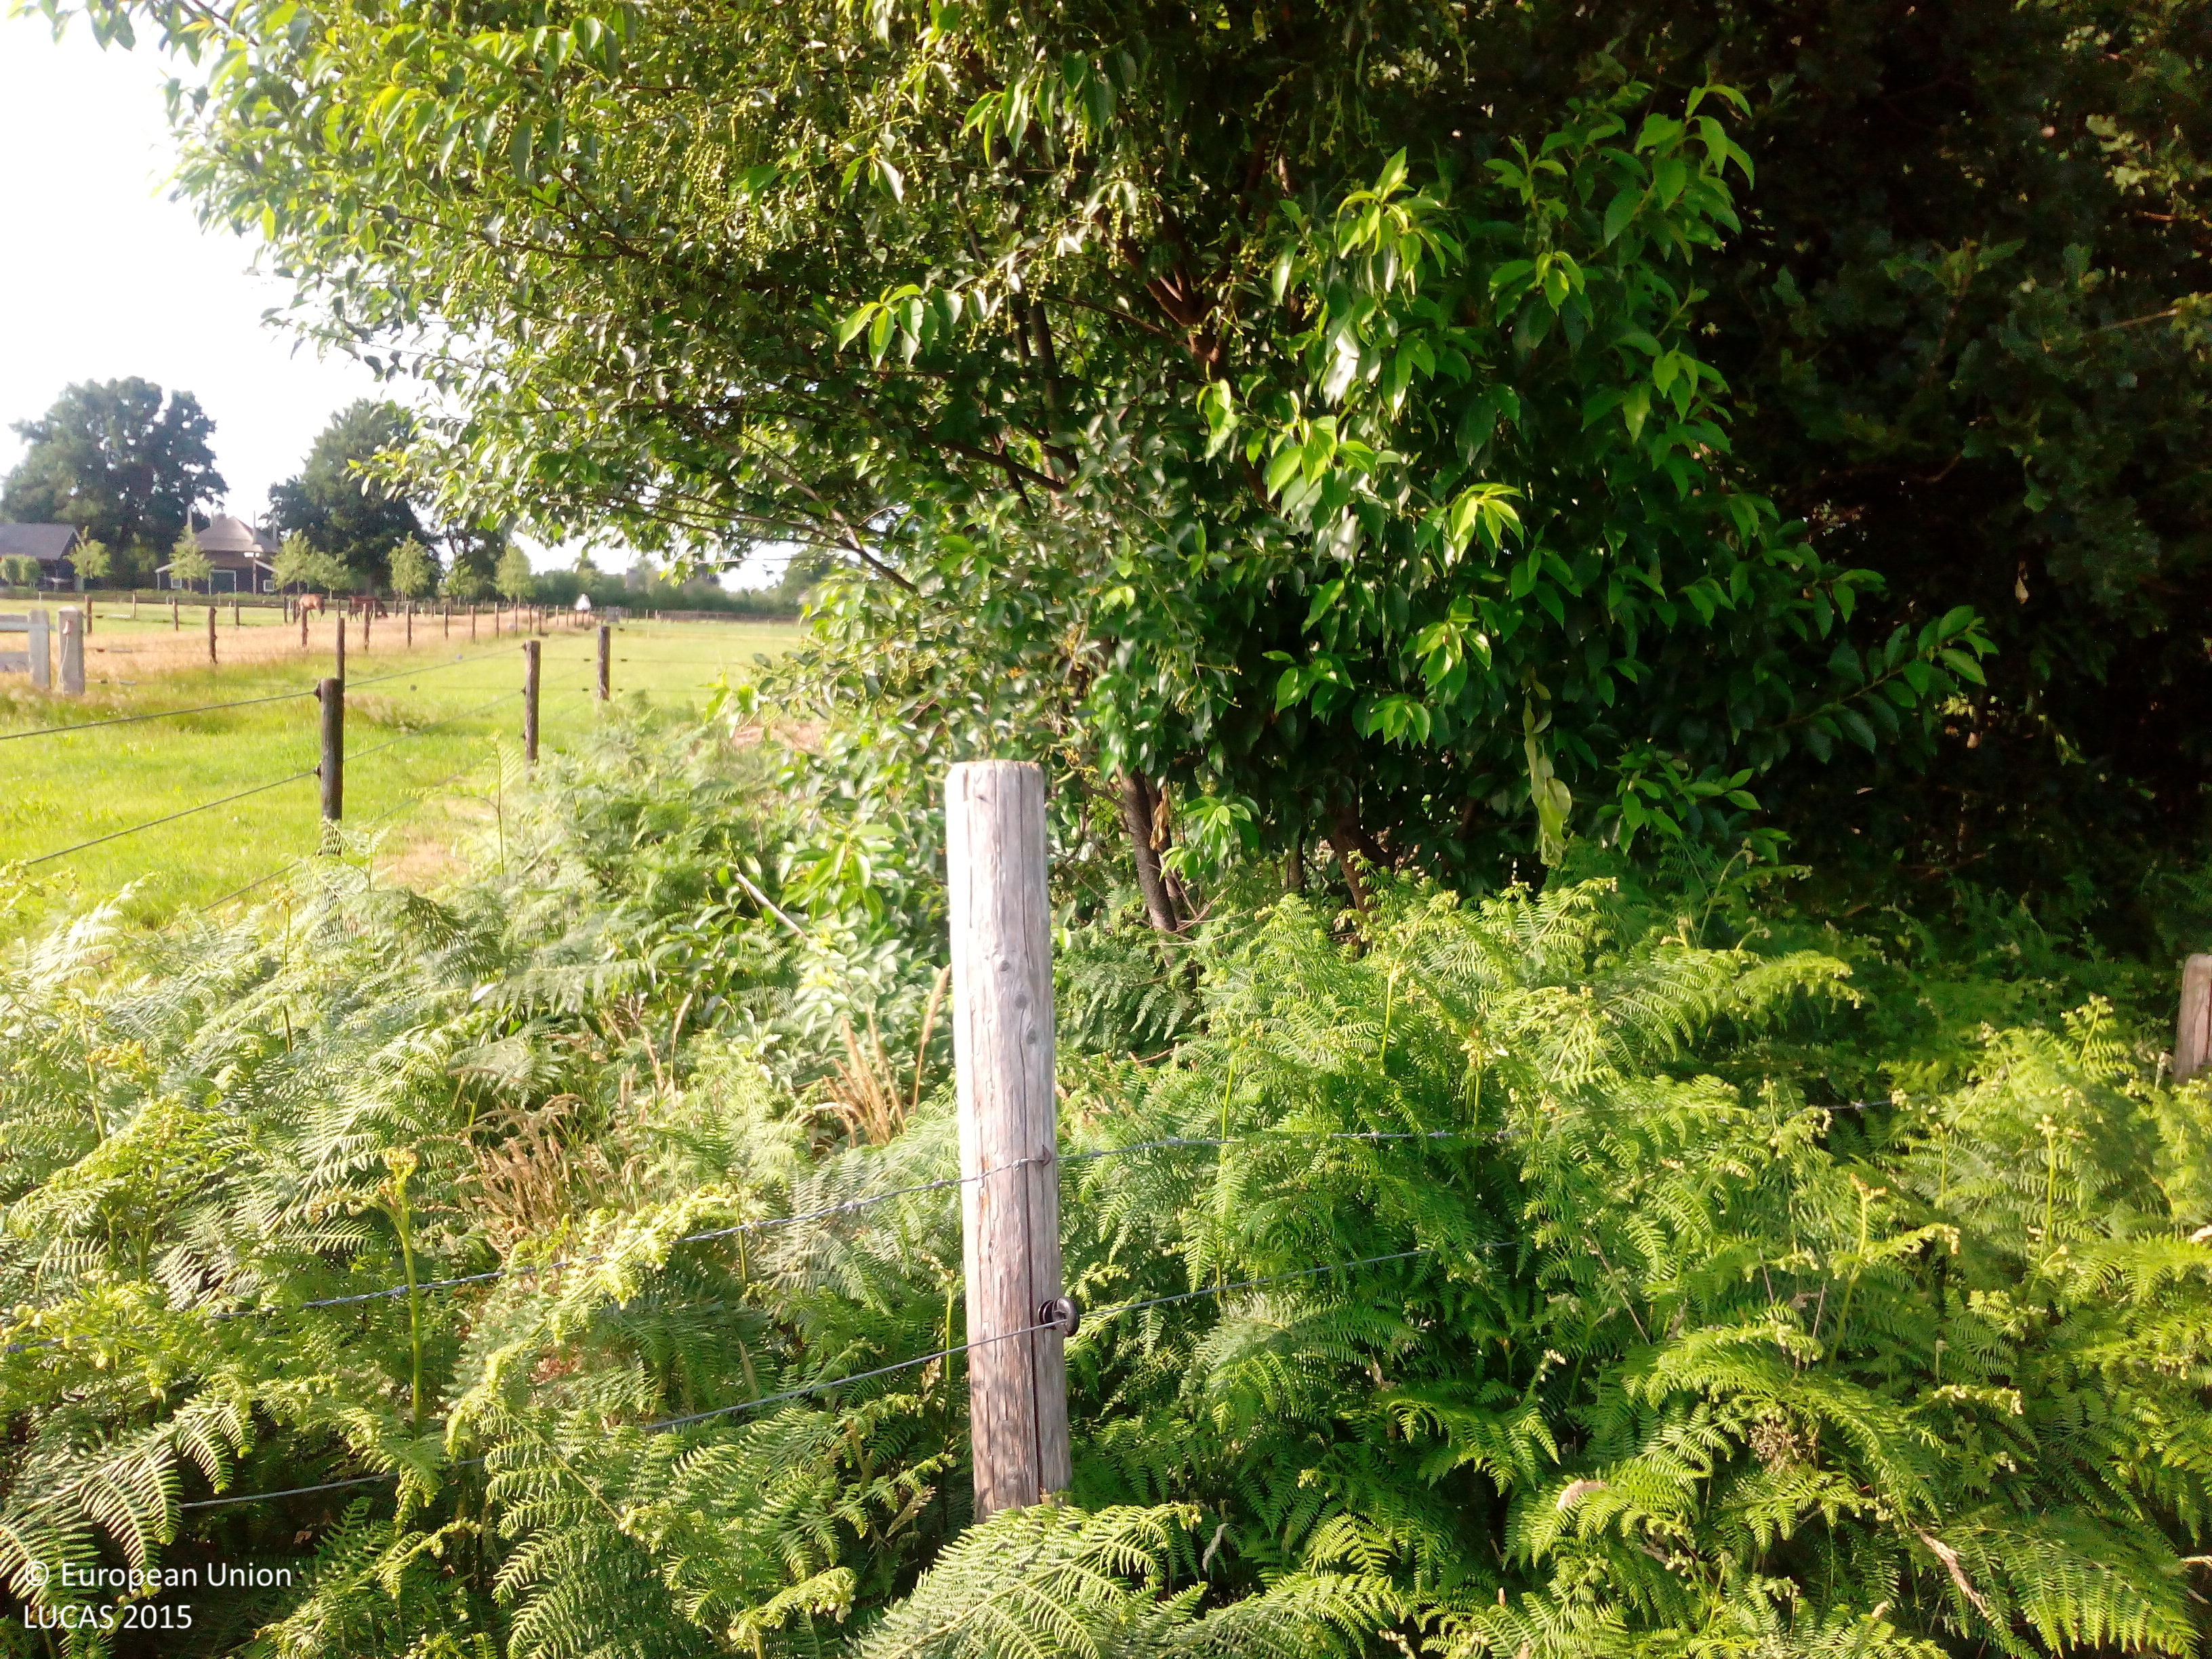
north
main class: Grassland
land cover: Grassland without tree/shrub cover
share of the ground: > 75 %
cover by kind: herbaceous plants 100 %
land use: Agriculture (excluding fallow land and kitchen gardens)
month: June
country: NL
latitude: 52.3525
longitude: 5.6676
